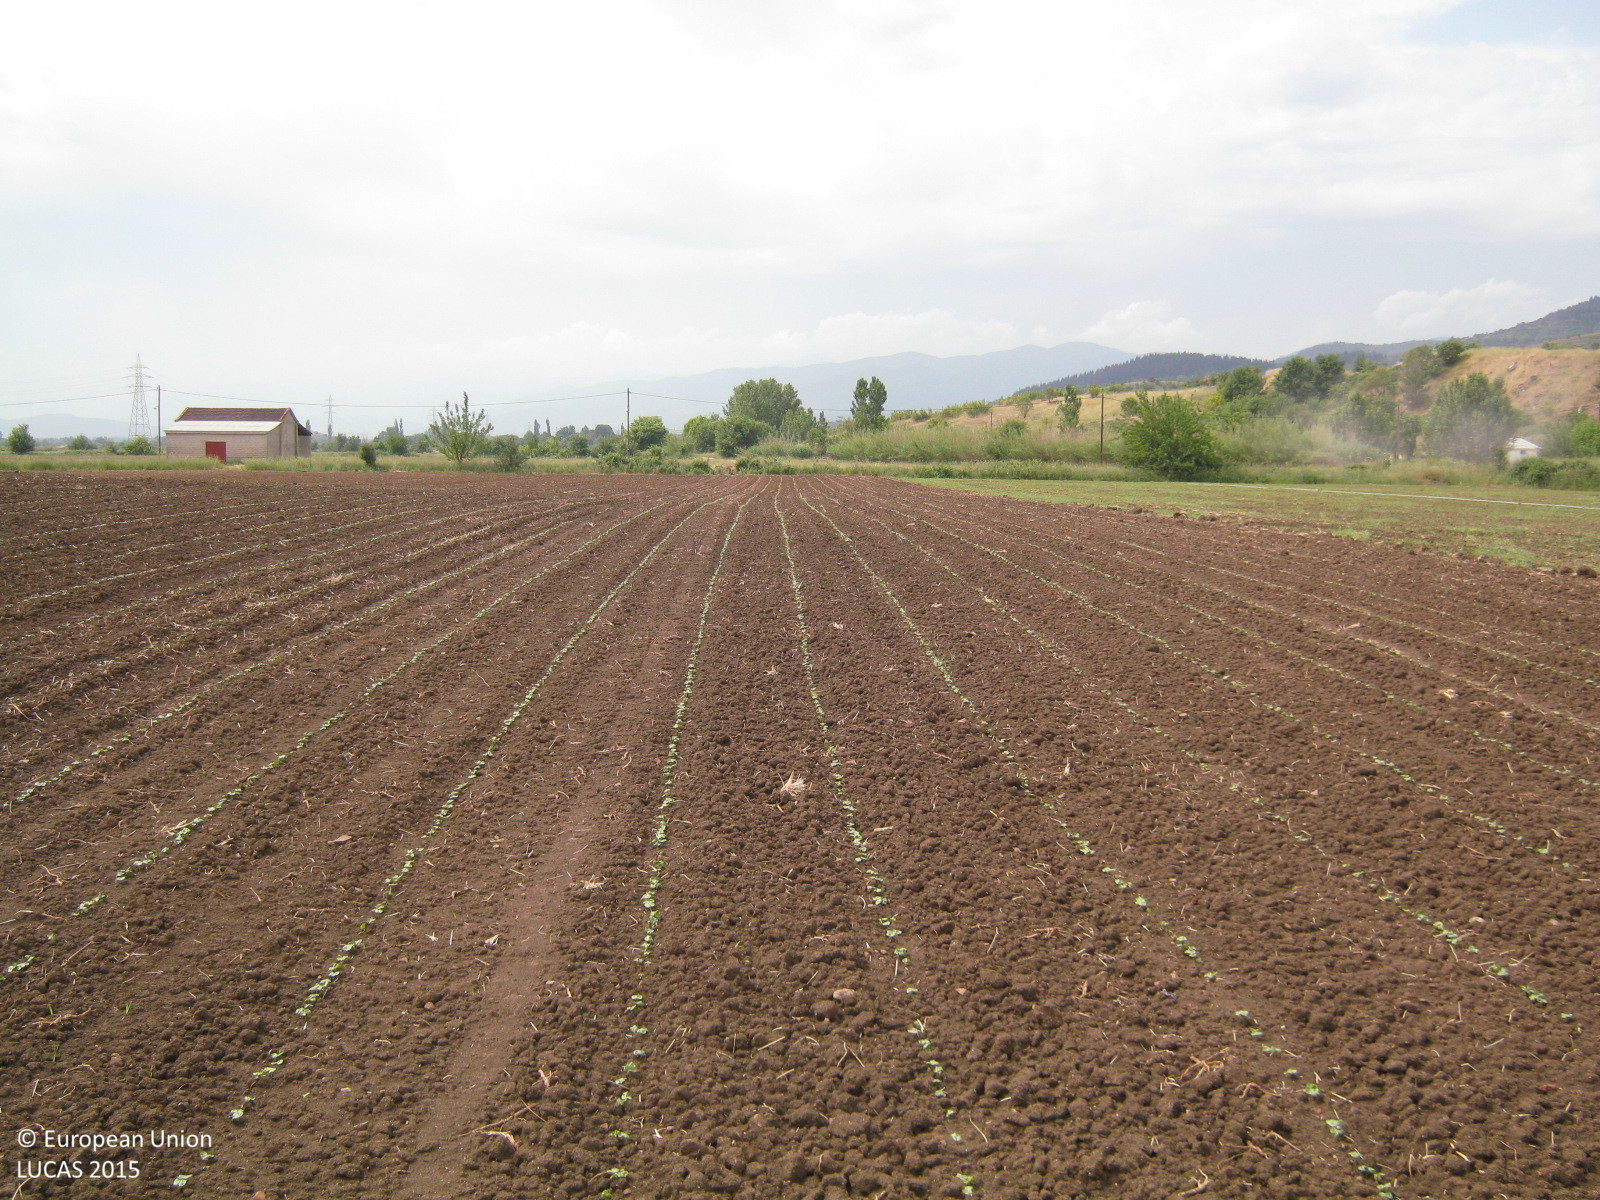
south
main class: Cropland
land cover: Cotton
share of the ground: < 10 %
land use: Agriculture (excluding fallow land and kitchen gardens)
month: May
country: GR
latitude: 39.4224
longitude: 21.8189
